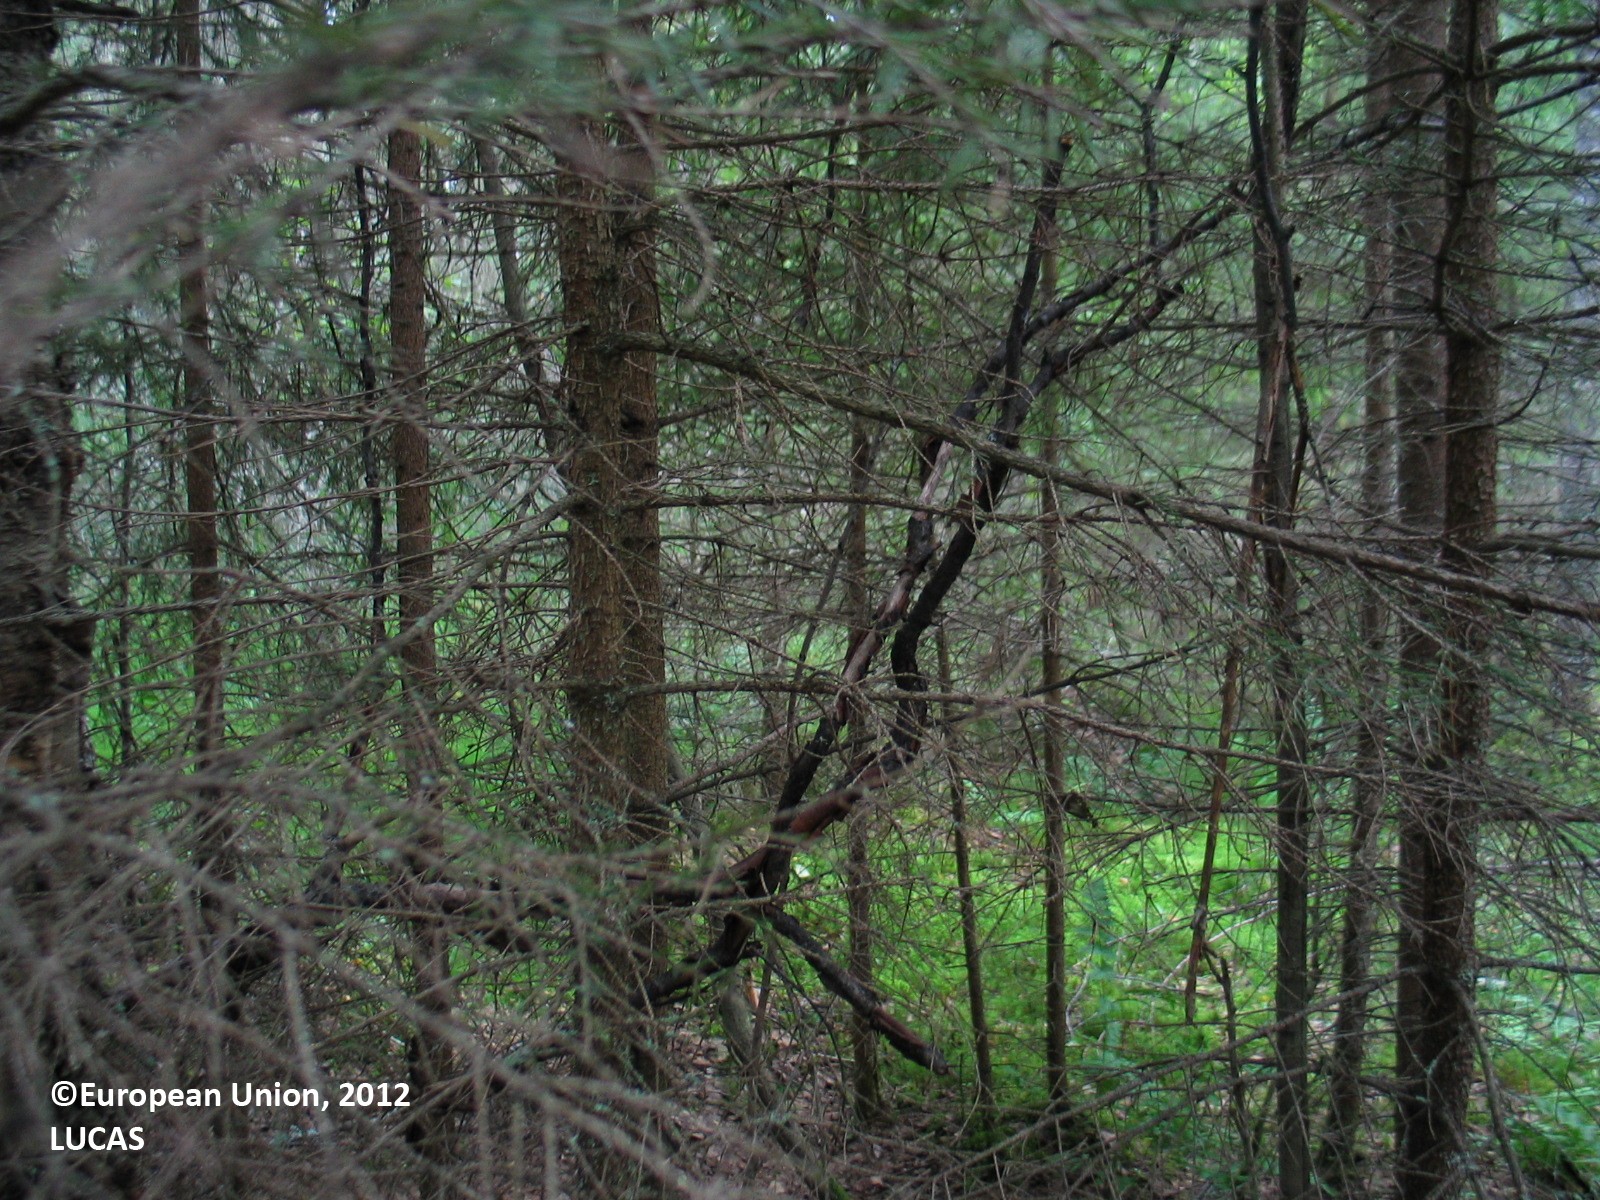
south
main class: Woodland
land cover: Other mixed woodland
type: mire and swamp forests
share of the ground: 50 - 75 %
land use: Forestry
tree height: > 5 m
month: July
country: FI
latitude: 64.5812
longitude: 26.3332
